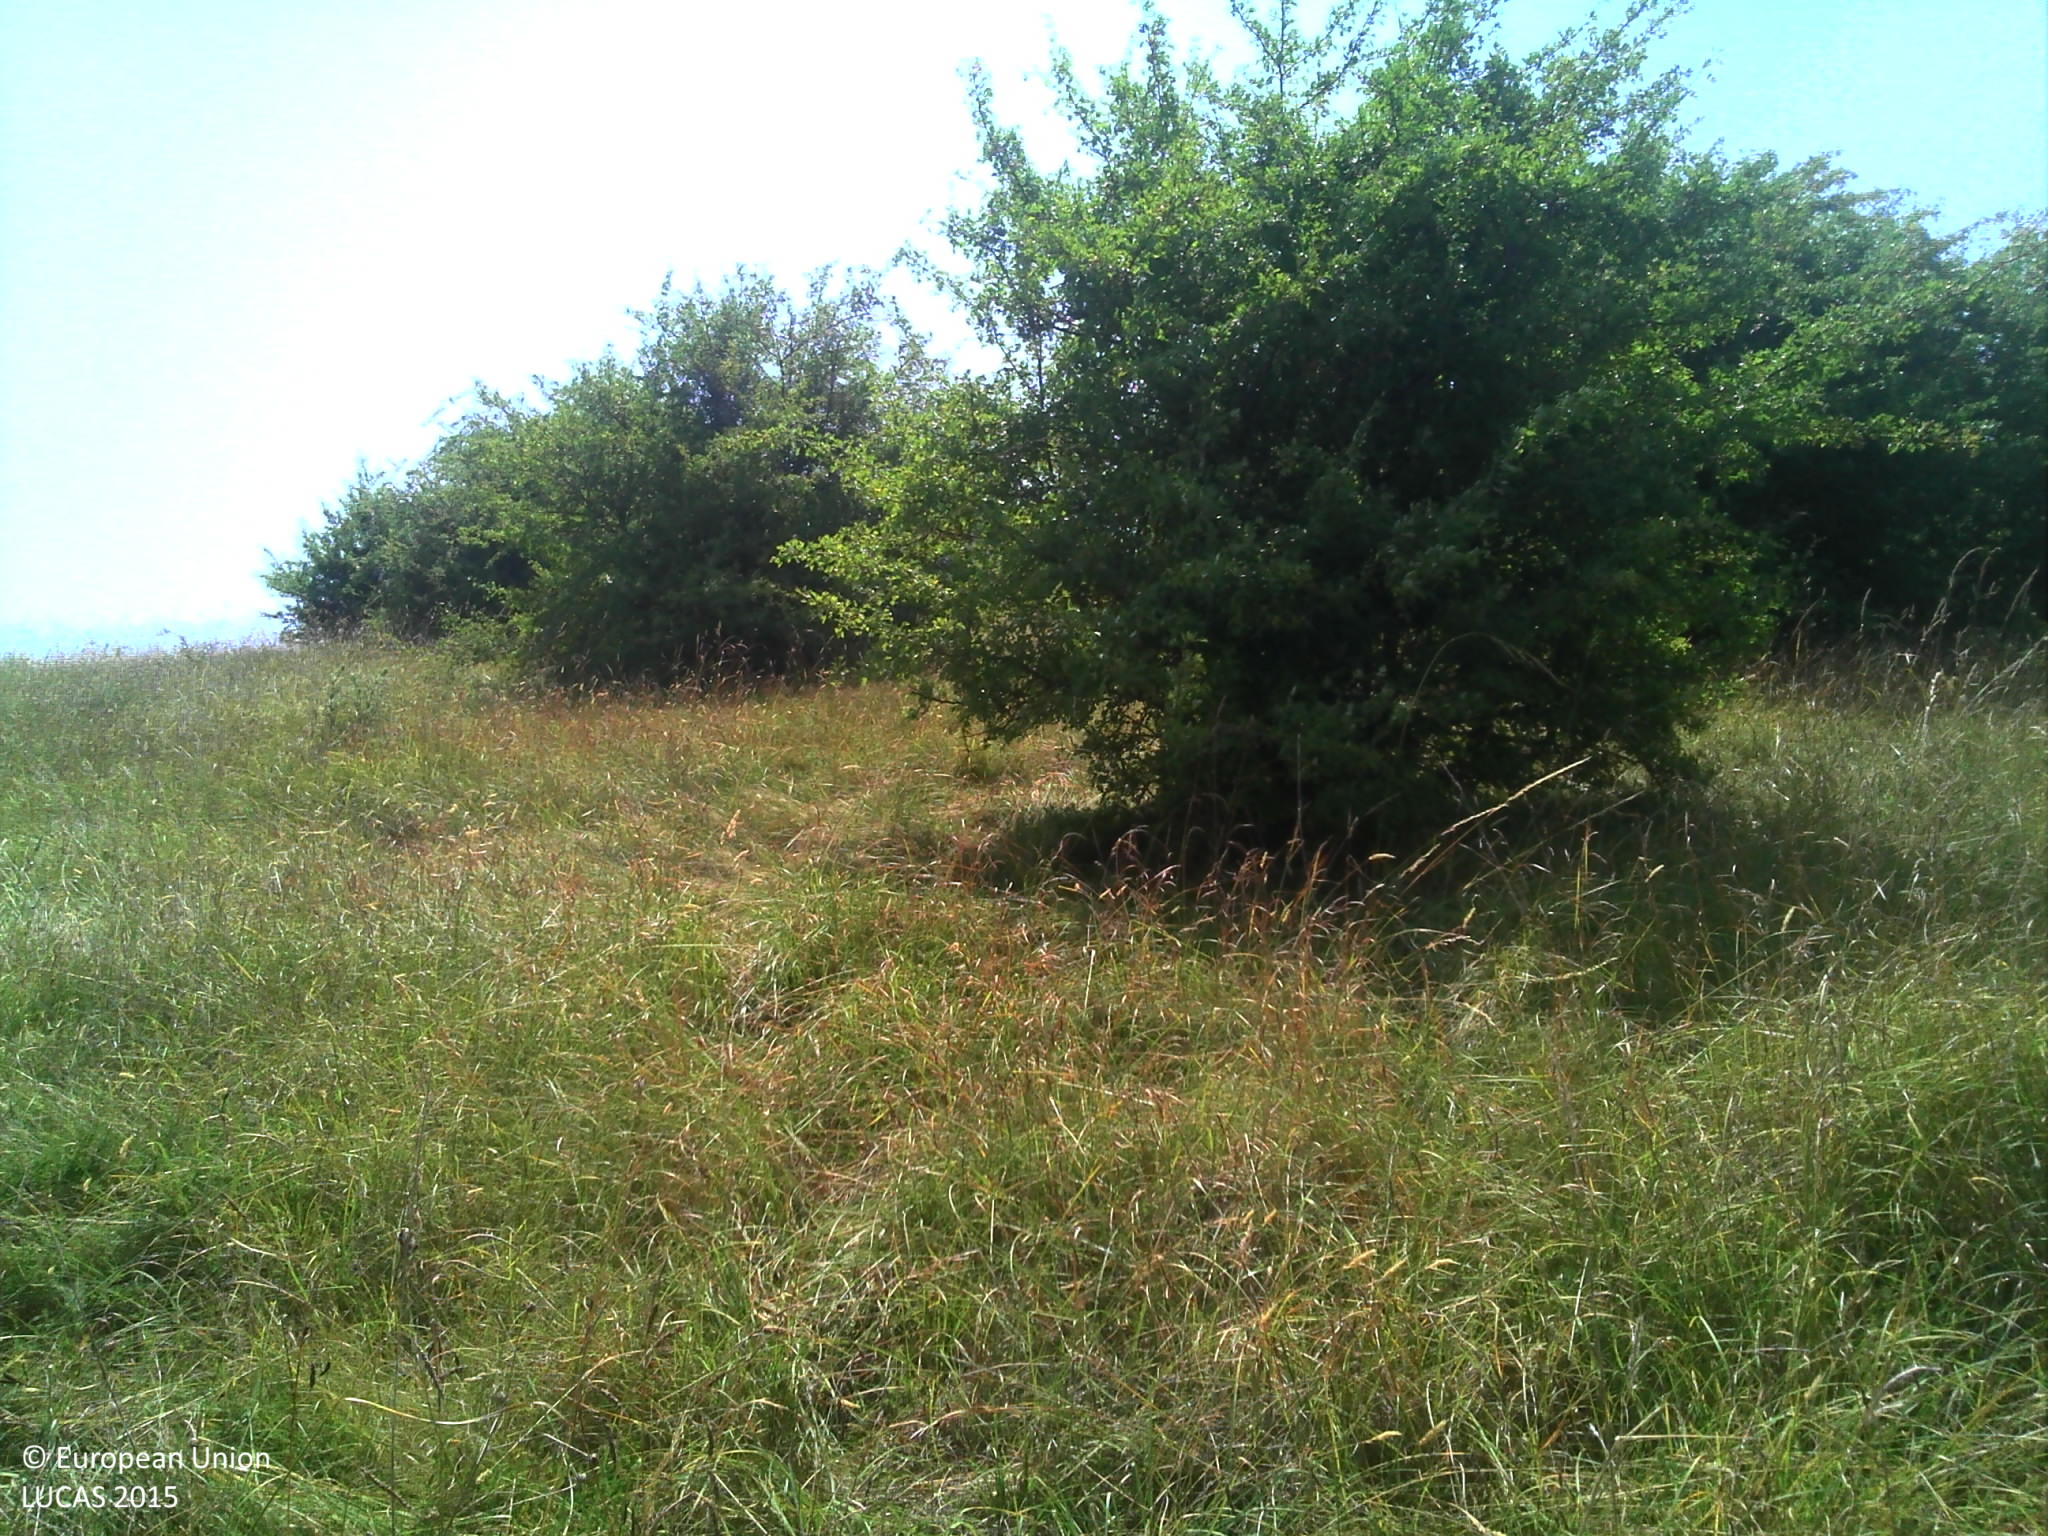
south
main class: Grassland
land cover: Grassland with sparse tree/shrub cover
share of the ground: > 75 %
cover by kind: herbaceous plants 95 %, broadleaved forest trees 5 %
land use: Agriculture (excluding fallow land and kitchen gardens)
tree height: < 5 m
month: July
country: FR
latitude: 43.3270
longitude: 1.0366
